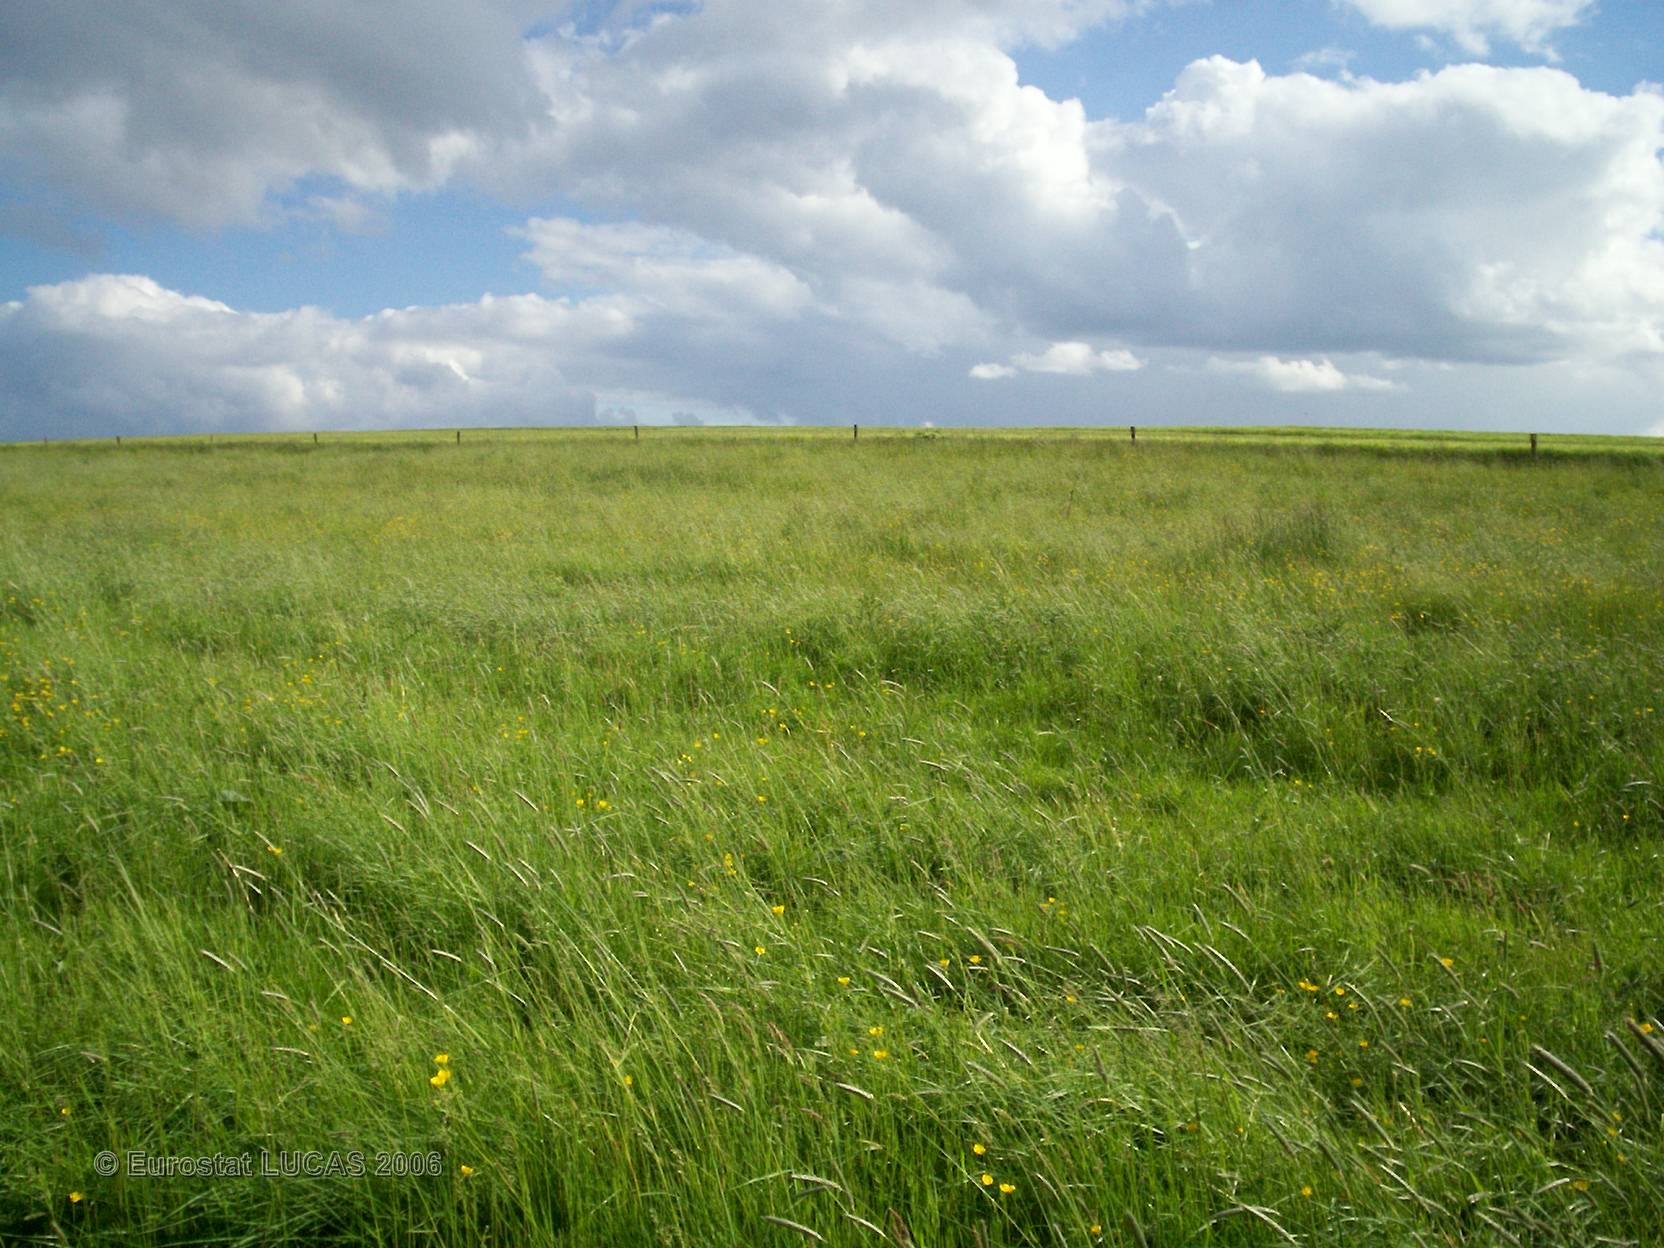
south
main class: Grassland
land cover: Grassland without tree/shrub cover
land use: Agriculture (excluding fallow land and kitchen gardens)
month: May
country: FR
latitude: 48.5183
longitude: 6.7649
